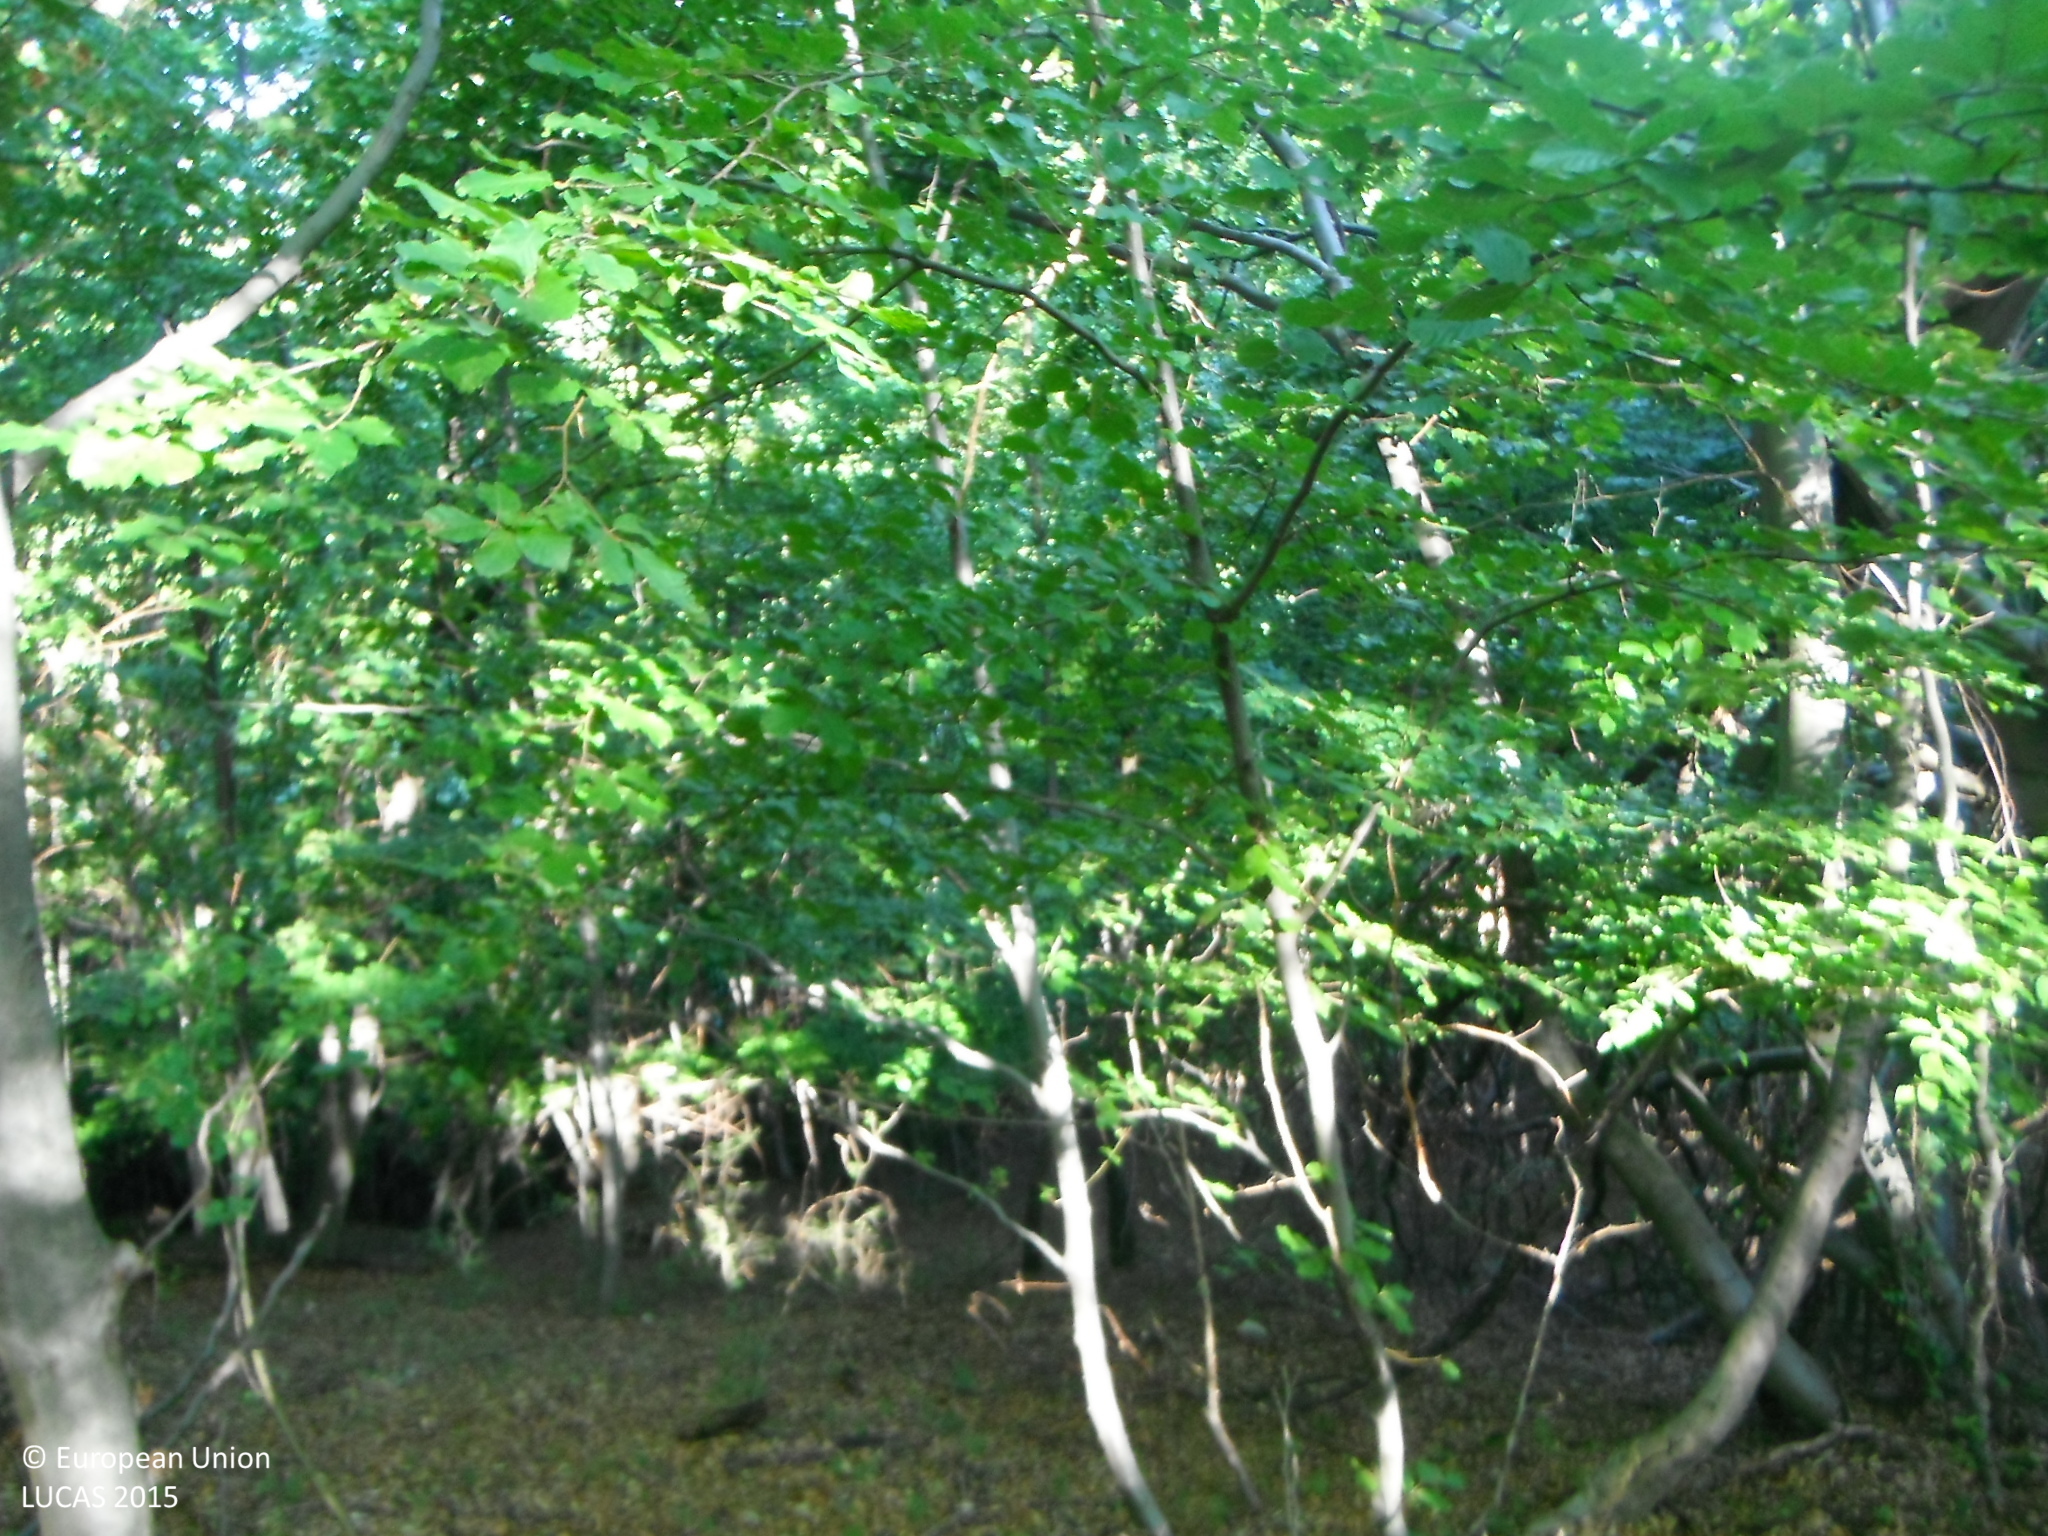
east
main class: Woodland
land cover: Broadleaved woodland
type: beech forest
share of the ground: > 75 %
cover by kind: broadleaved forest trees 90 %, shrubs 5 %
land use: Forestry
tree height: > 5 m
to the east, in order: Broadleaved woodland; Rivers and streams; Broadleaved woodland; Tracks; Broadleaved woodland; Shrubland with sparse tree cover
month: September
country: SK
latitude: 48.8316
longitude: 18.3125
